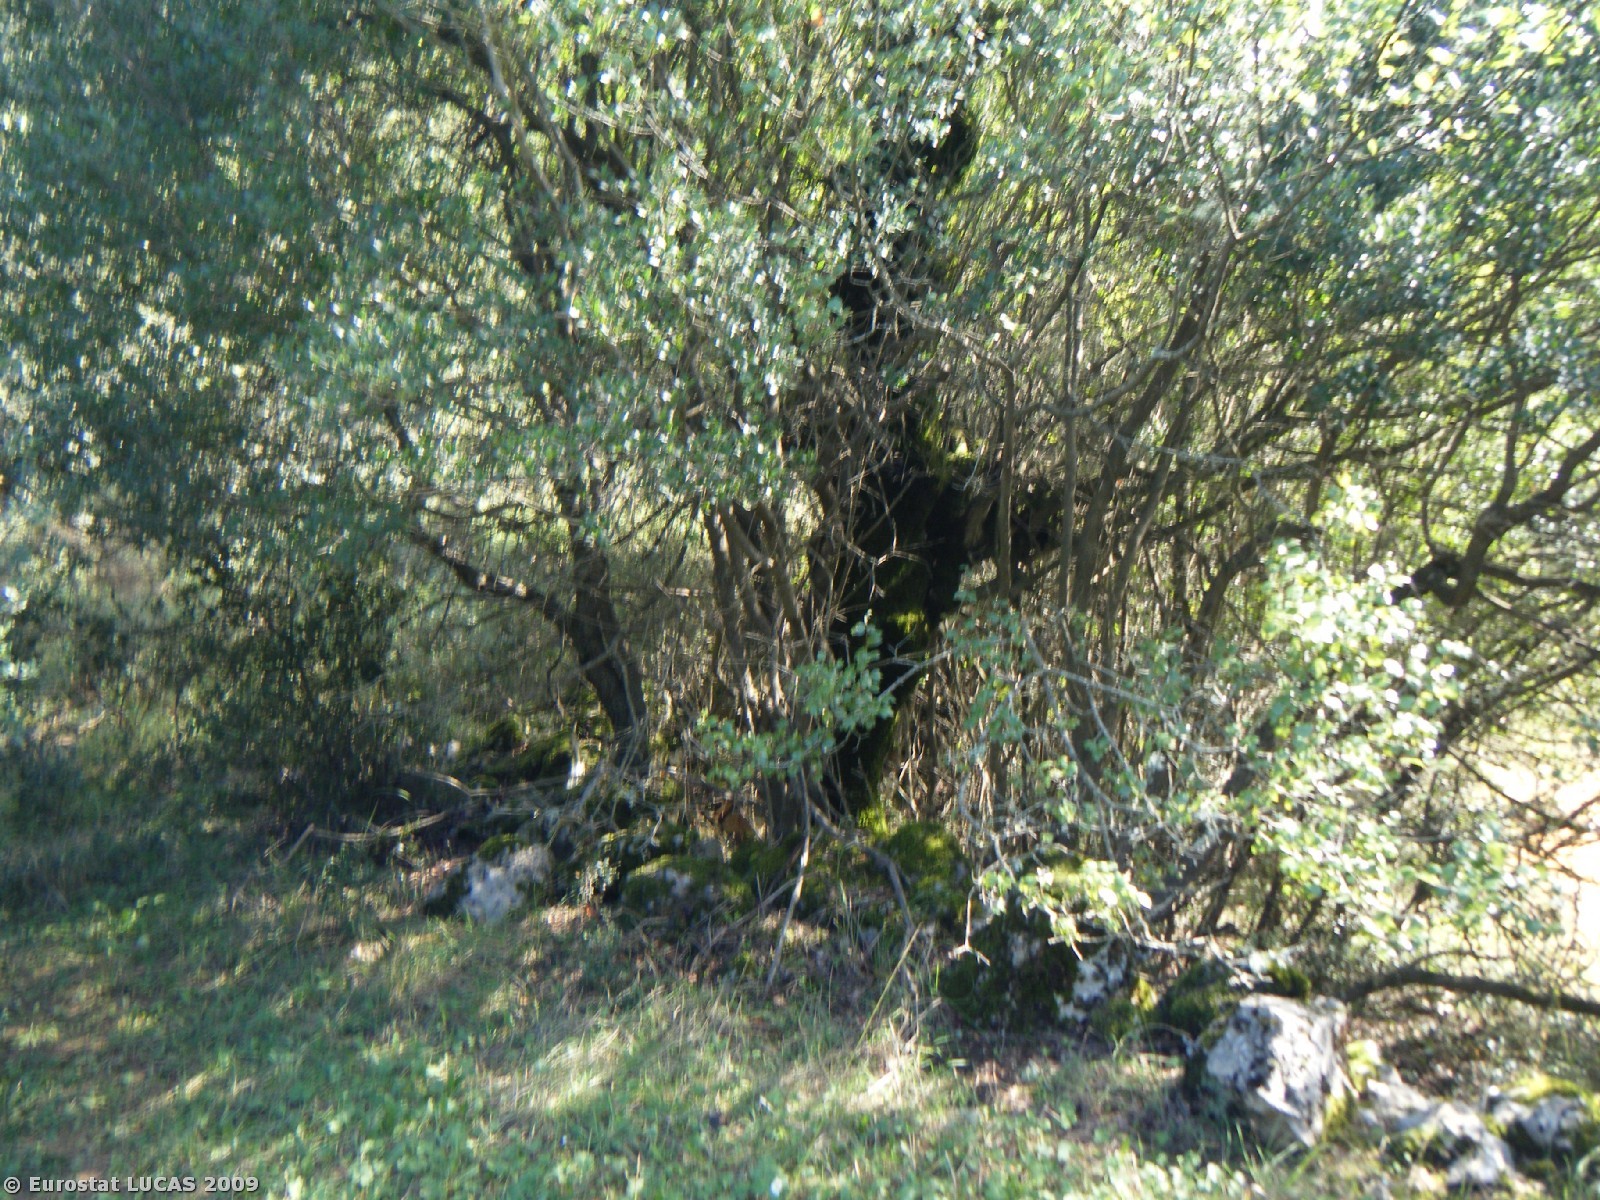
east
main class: Woodland
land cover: Broadleaved woodland
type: thermophilous deciduous forest
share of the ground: > 75 %
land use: Agriculture (excluding fallow land and kitchen gardens)
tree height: > 5 m
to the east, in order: Broadleaved woodland; Grassland with sparse tree/shrub cover; Shrubland without tree cover; Grassland with sparse tree/shrub cover; Tracks; Shrubland without tree cover; Broadleaved woodland
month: October
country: GR
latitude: 37.4532
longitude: 22.2027
